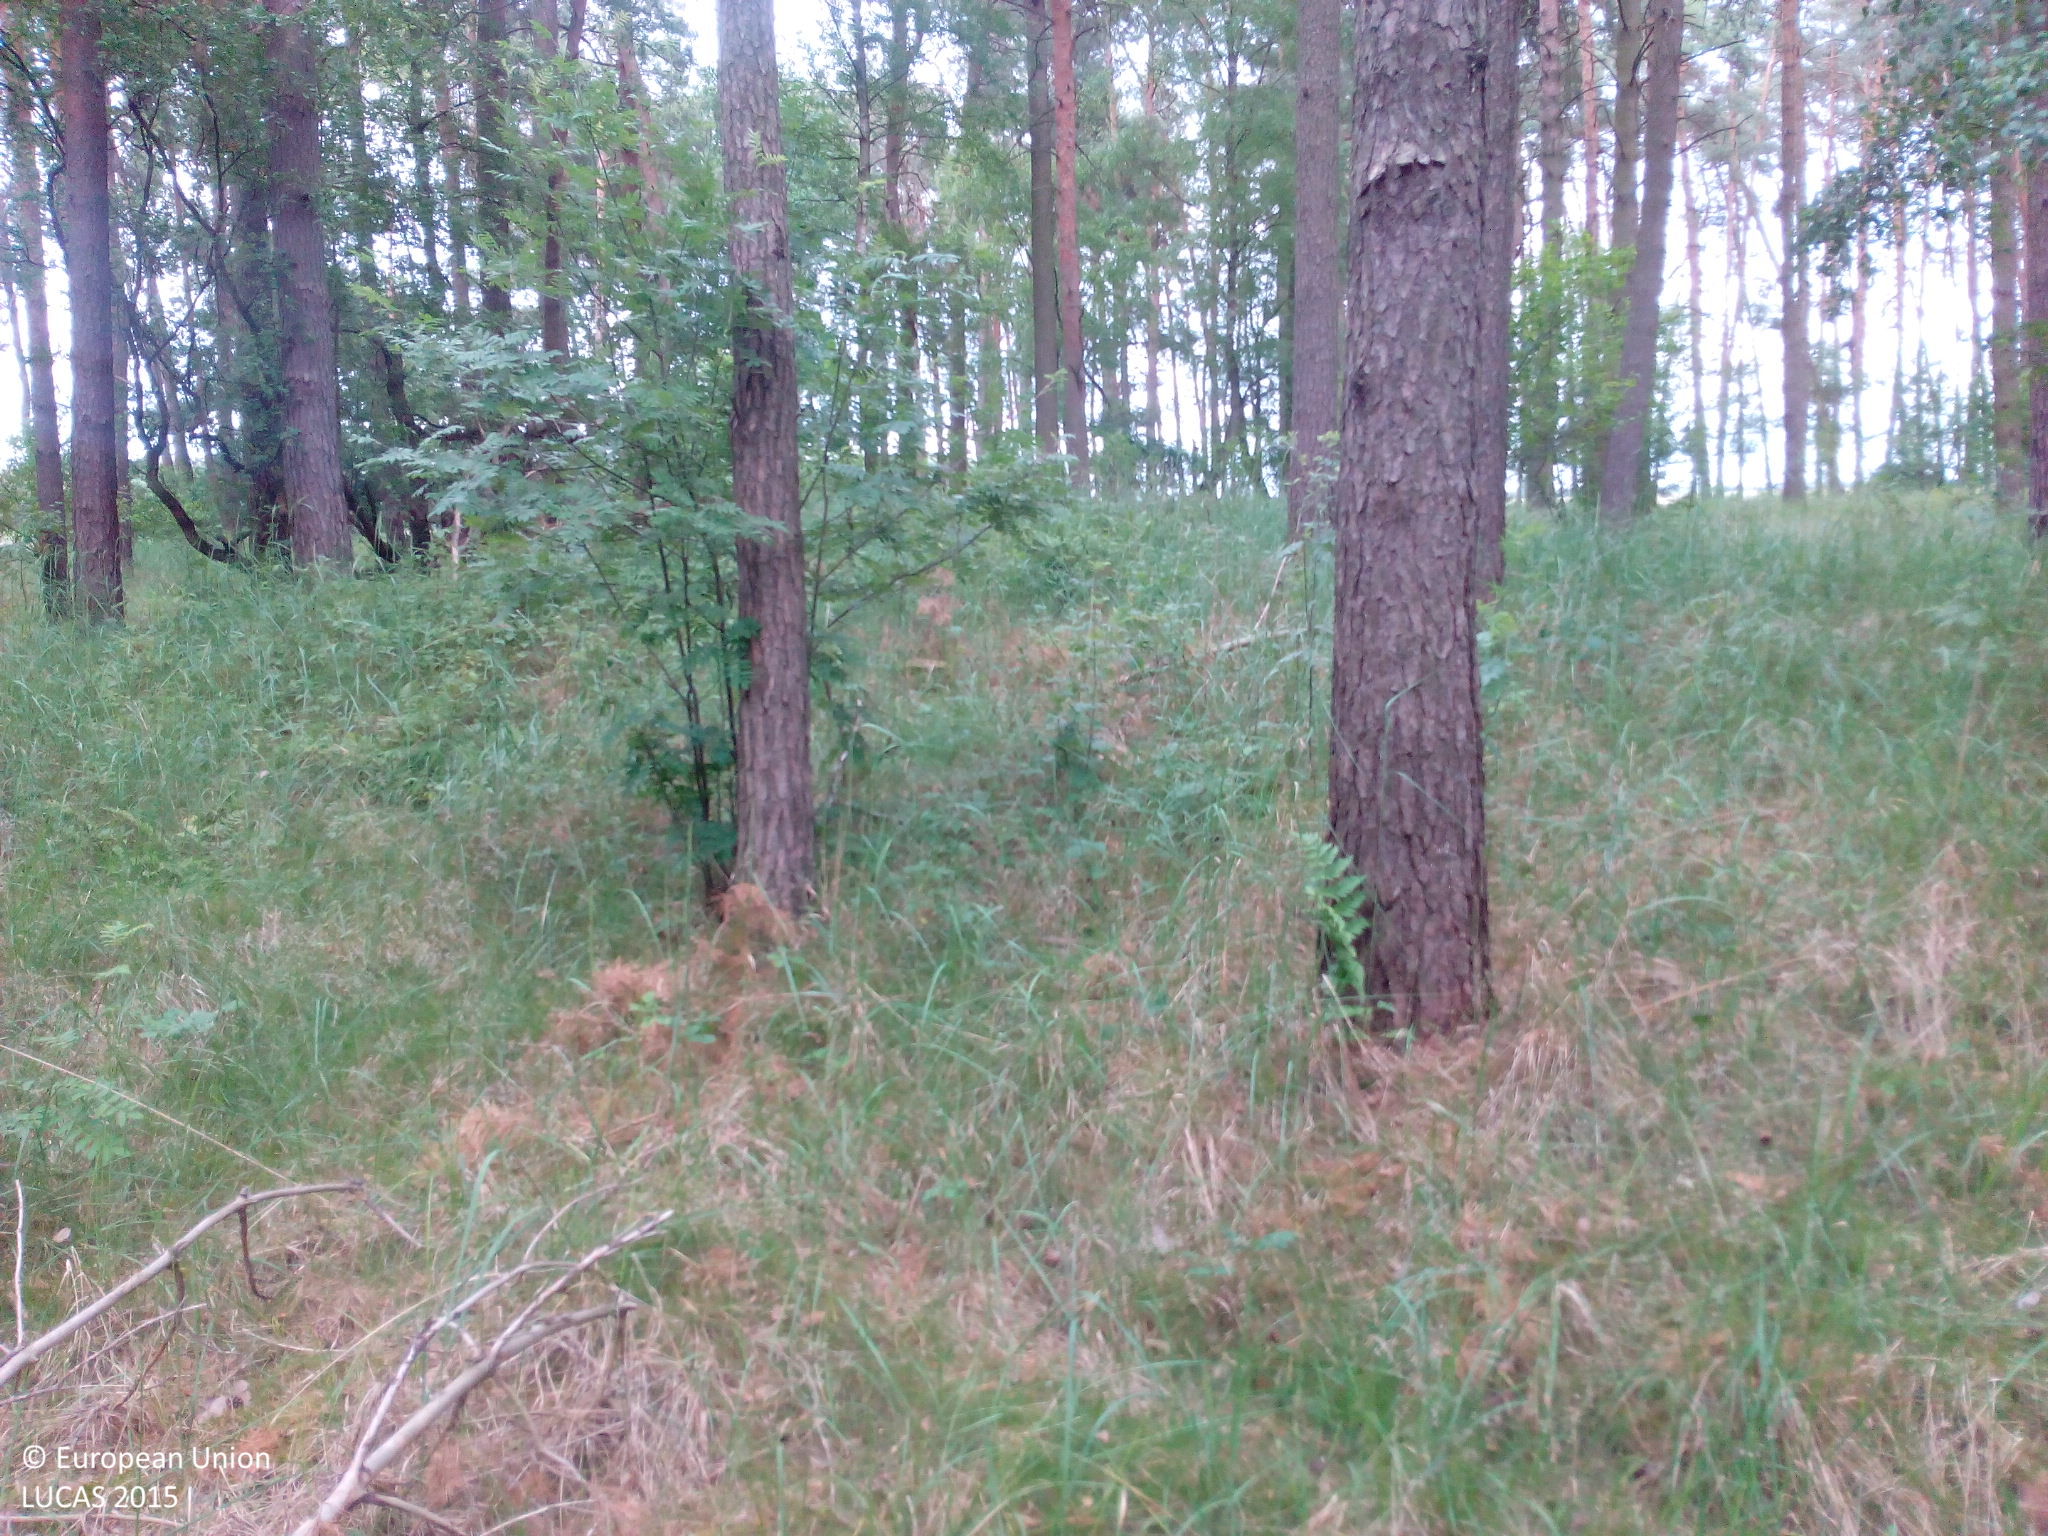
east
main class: Woodland
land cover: Pine dominated coniferous woodland
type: hemiboreal forest and nemoral coniferous forest and mixed broadleaved-coniferous forest
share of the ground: > 75 %
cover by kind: coniferous forest trees 80 %, herbaceous plants 15 %, lichens and mosses 5 %
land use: Forestry
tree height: > 5 m
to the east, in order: Pine dominated coniferous woodland; Rye; Ditches and canals
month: June
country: DE
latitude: 52.4803
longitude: 12.3407
